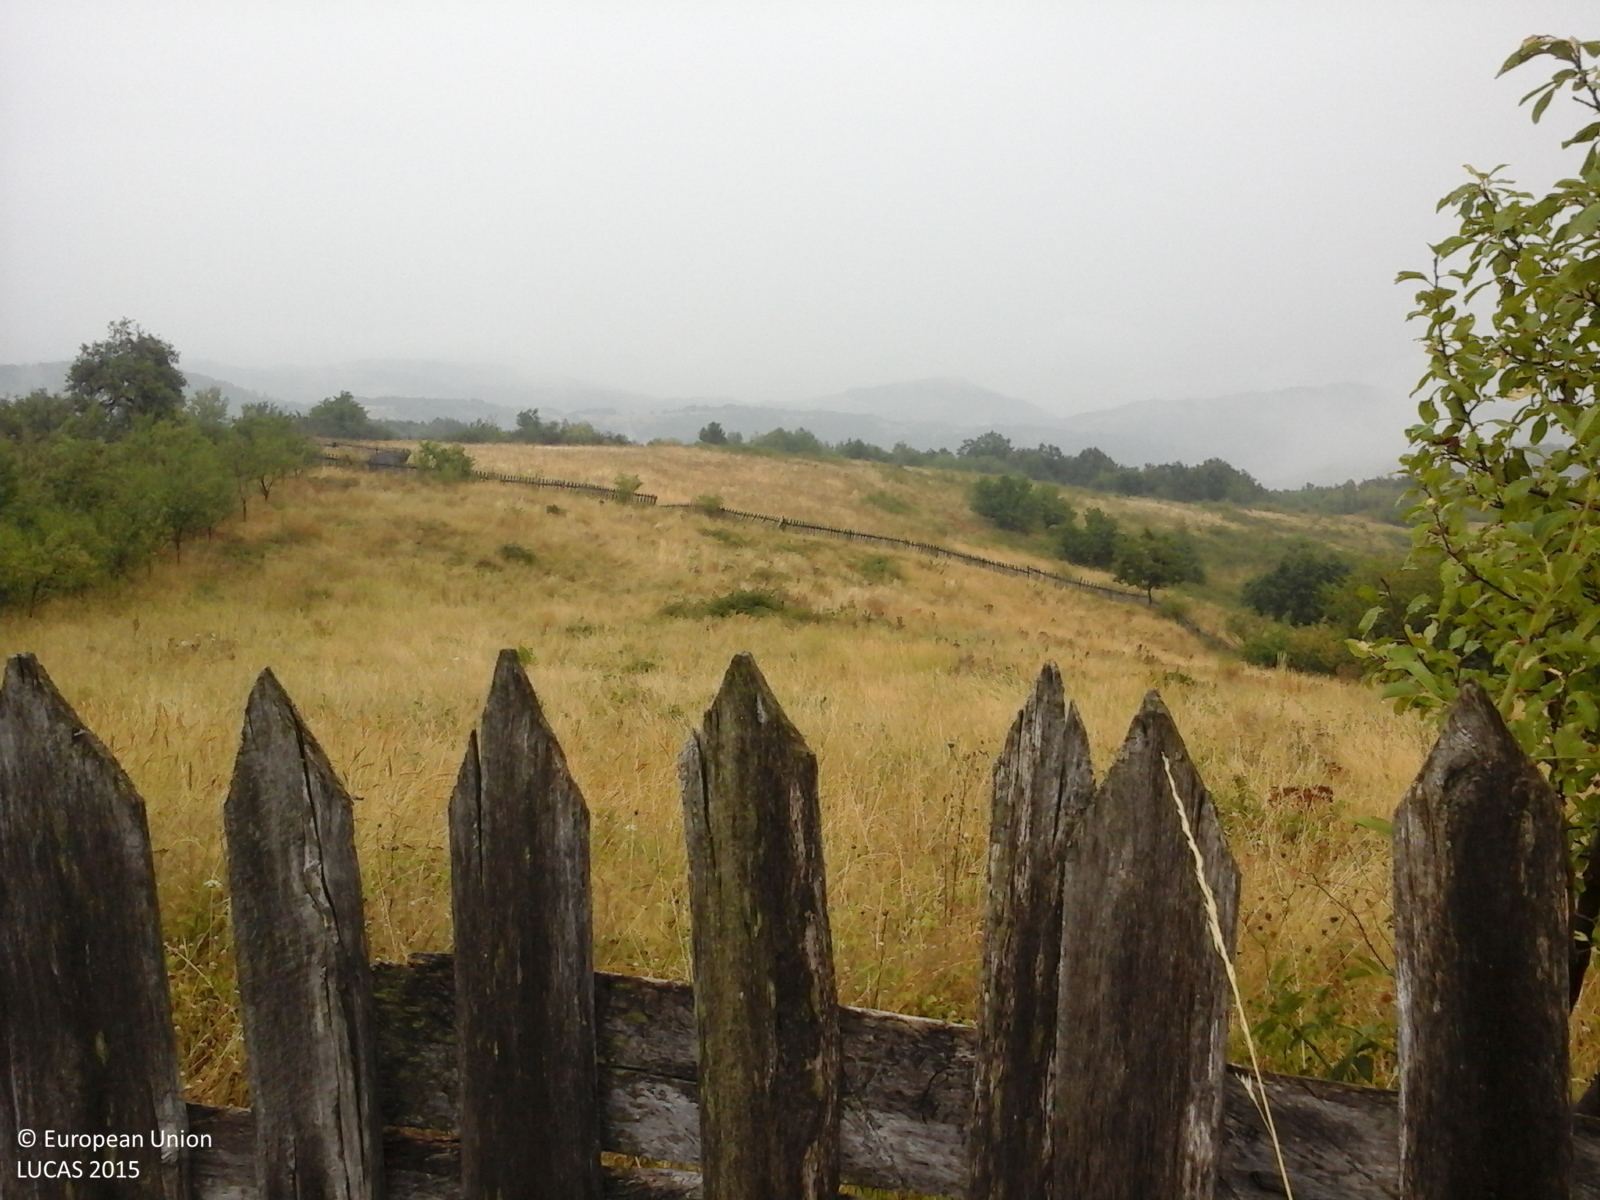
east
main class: Grassland
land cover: Spontaneously vegetated surfaces
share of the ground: > 75 %
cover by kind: herbaceous plants 100 %
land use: Fallow land
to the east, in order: Spontaneously vegetated surfaces; Fences; Spontaneously vegetated surfaces; Grassland with sparse tree/shrub cover; Spontaneously vegetated surfaces; Fences; Spontaneously vegetated surfaces; Shrubland without tree cover
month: August
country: RO
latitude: 44.5620
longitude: 22.1587
